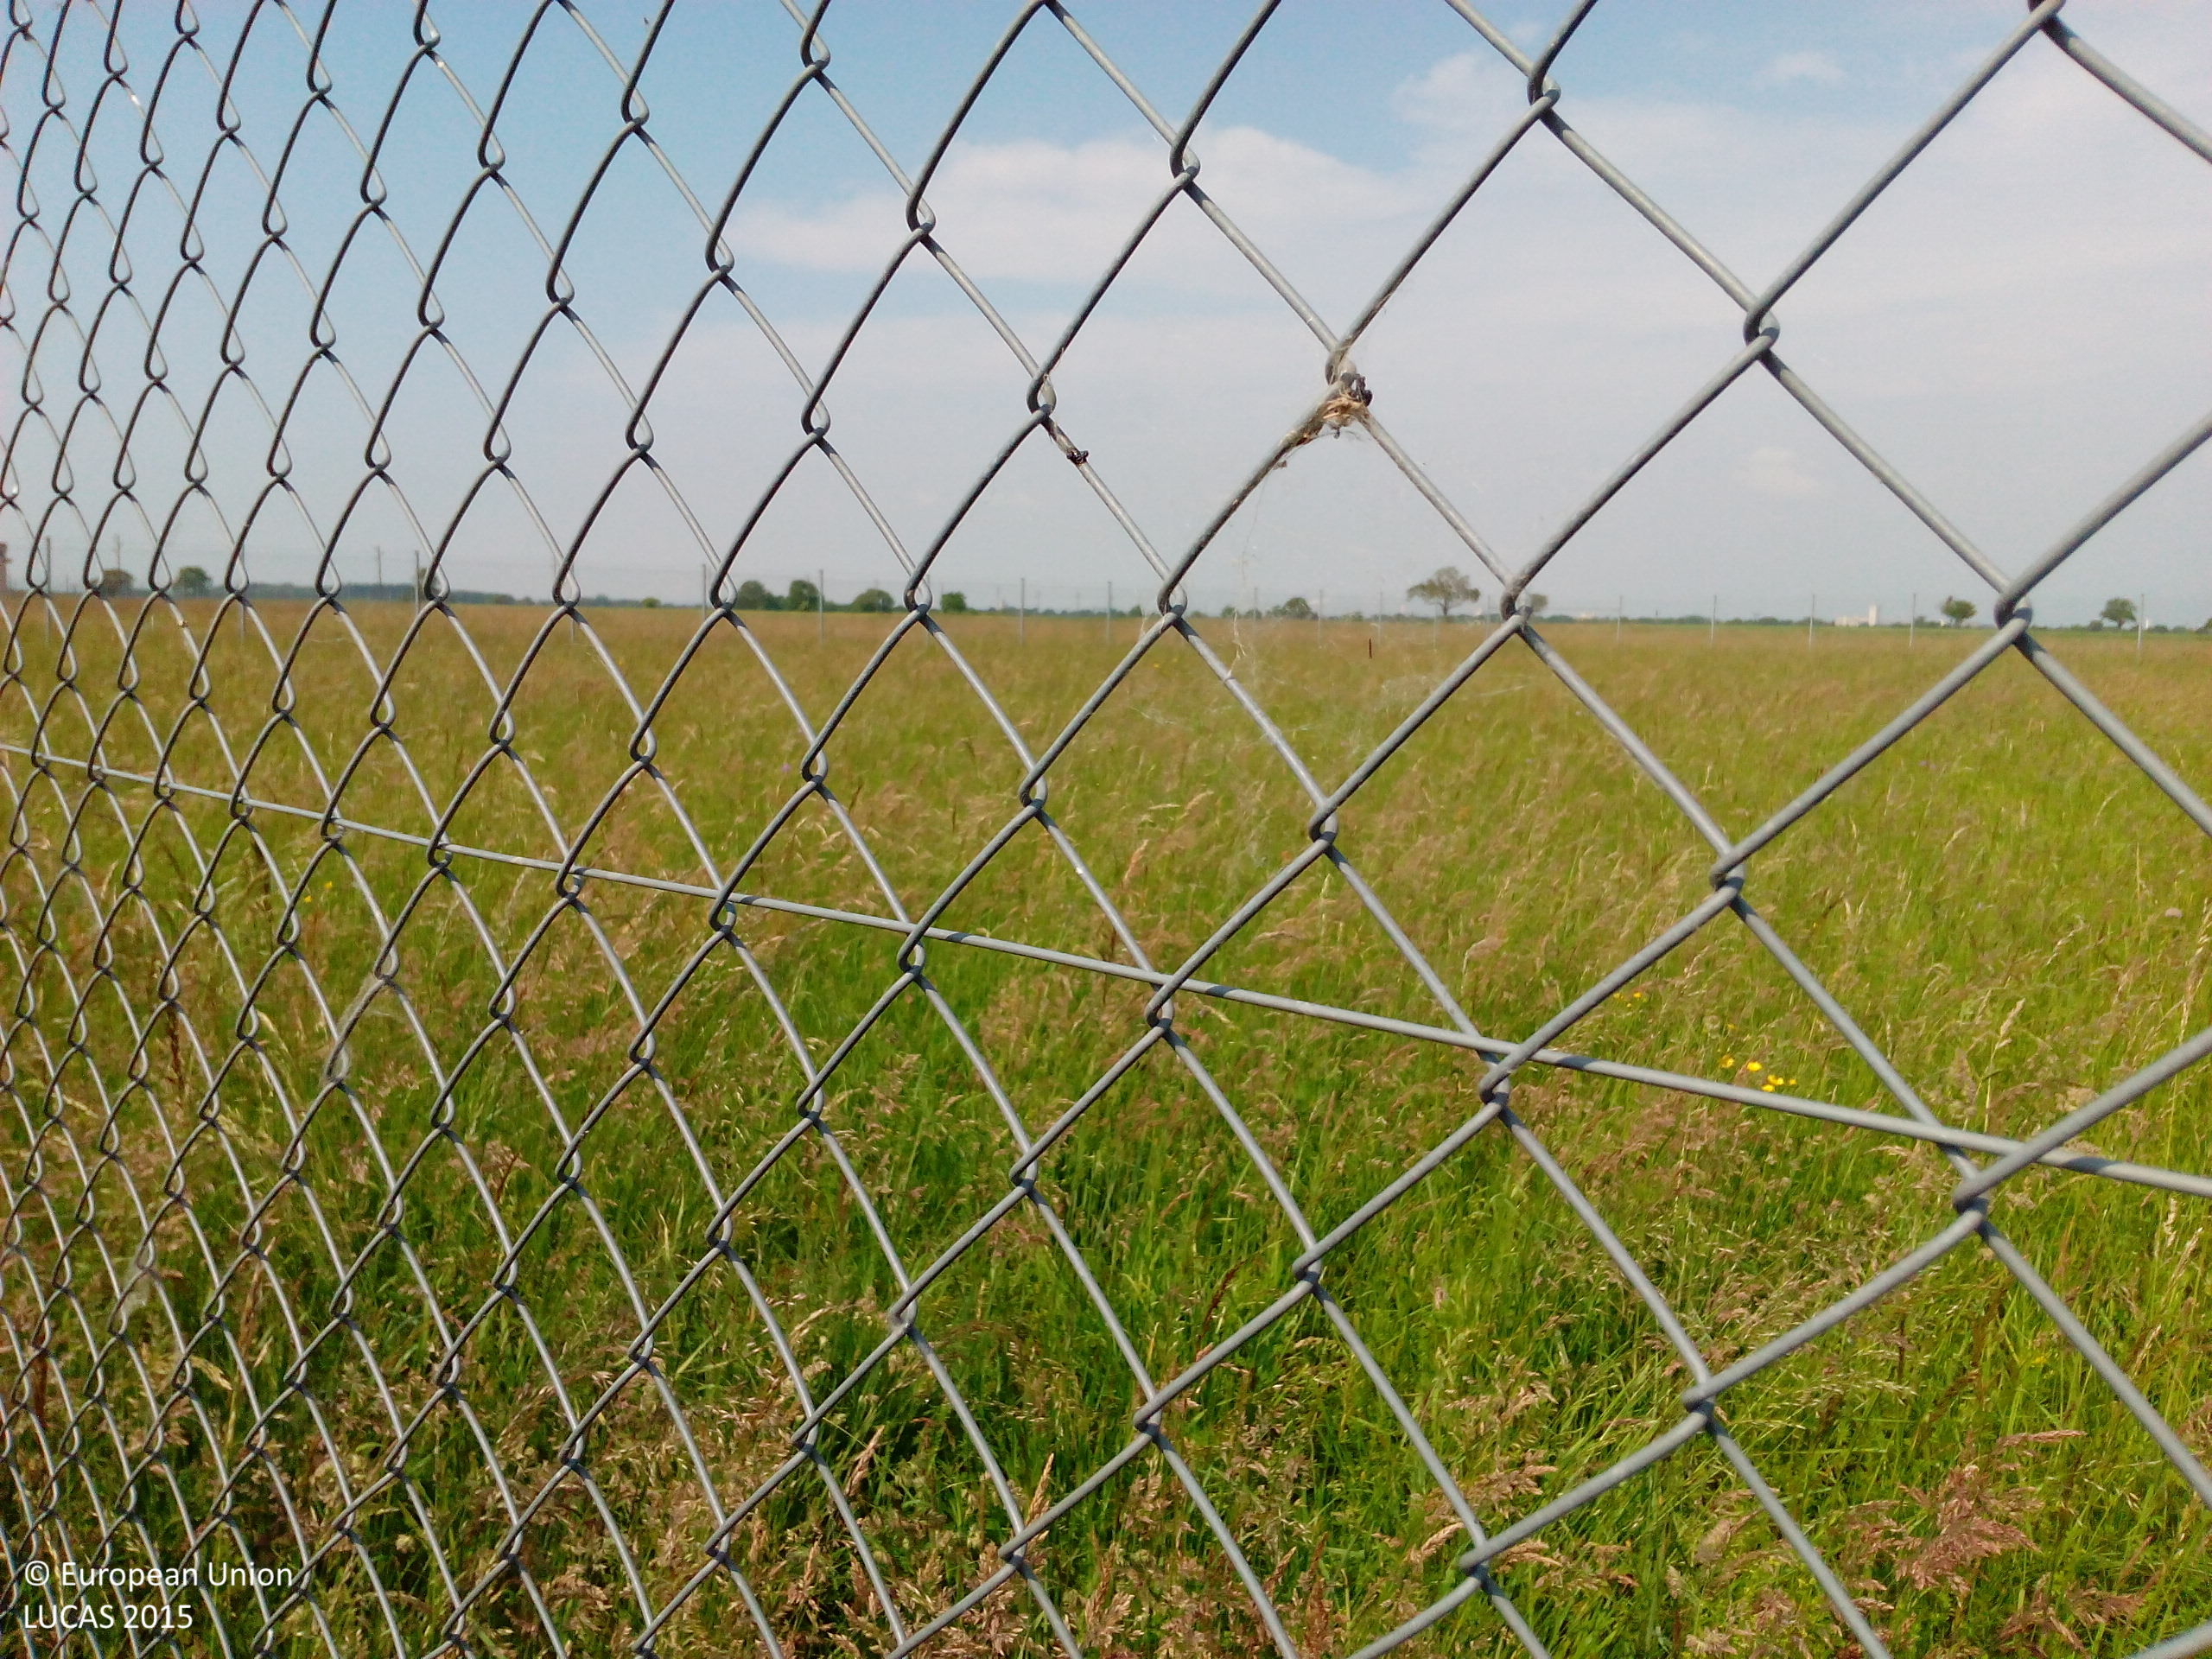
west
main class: Grassland
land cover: Grassland without tree/shrub cover
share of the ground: > 75 %
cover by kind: herbaceous plants 100 %
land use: Water supply and treatment
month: May
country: DE
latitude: 47.8010
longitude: 7.5848
